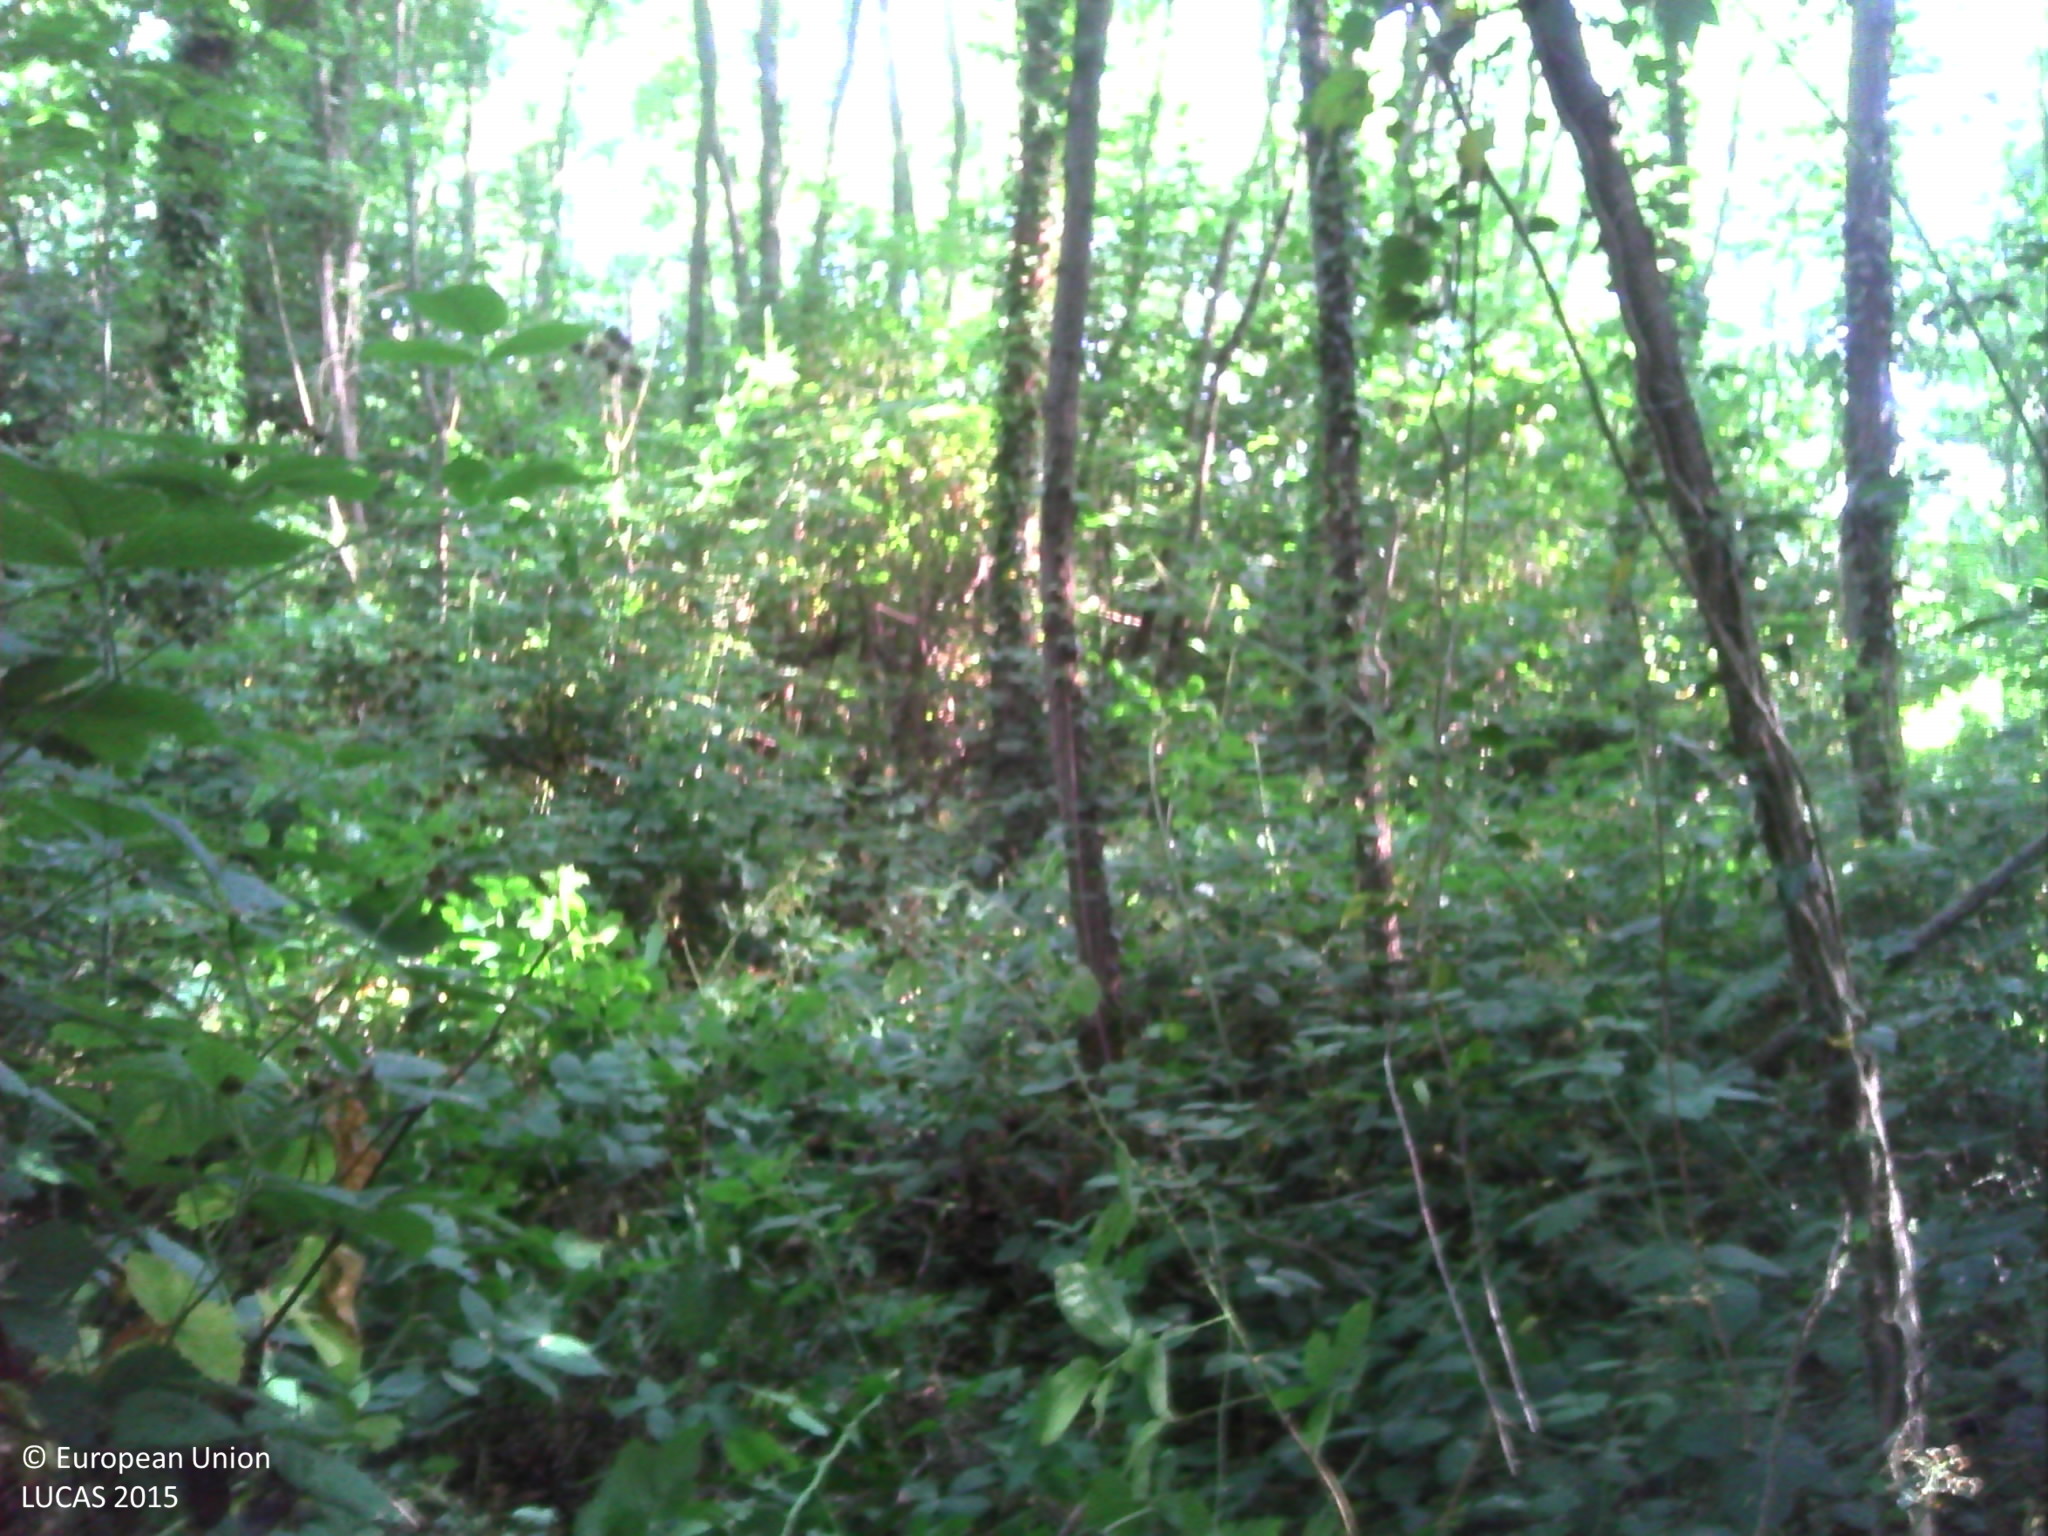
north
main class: Woodland
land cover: Broadleaved woodland
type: mesophytic deciduous forest
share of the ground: > 75 %
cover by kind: broadleaved forest trees 80 %, herbaceous plants 15 %, lichens and mosses 5 %
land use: Forestry
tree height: > 5 m
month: July
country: FR
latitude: 48.2413
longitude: 3.3825
